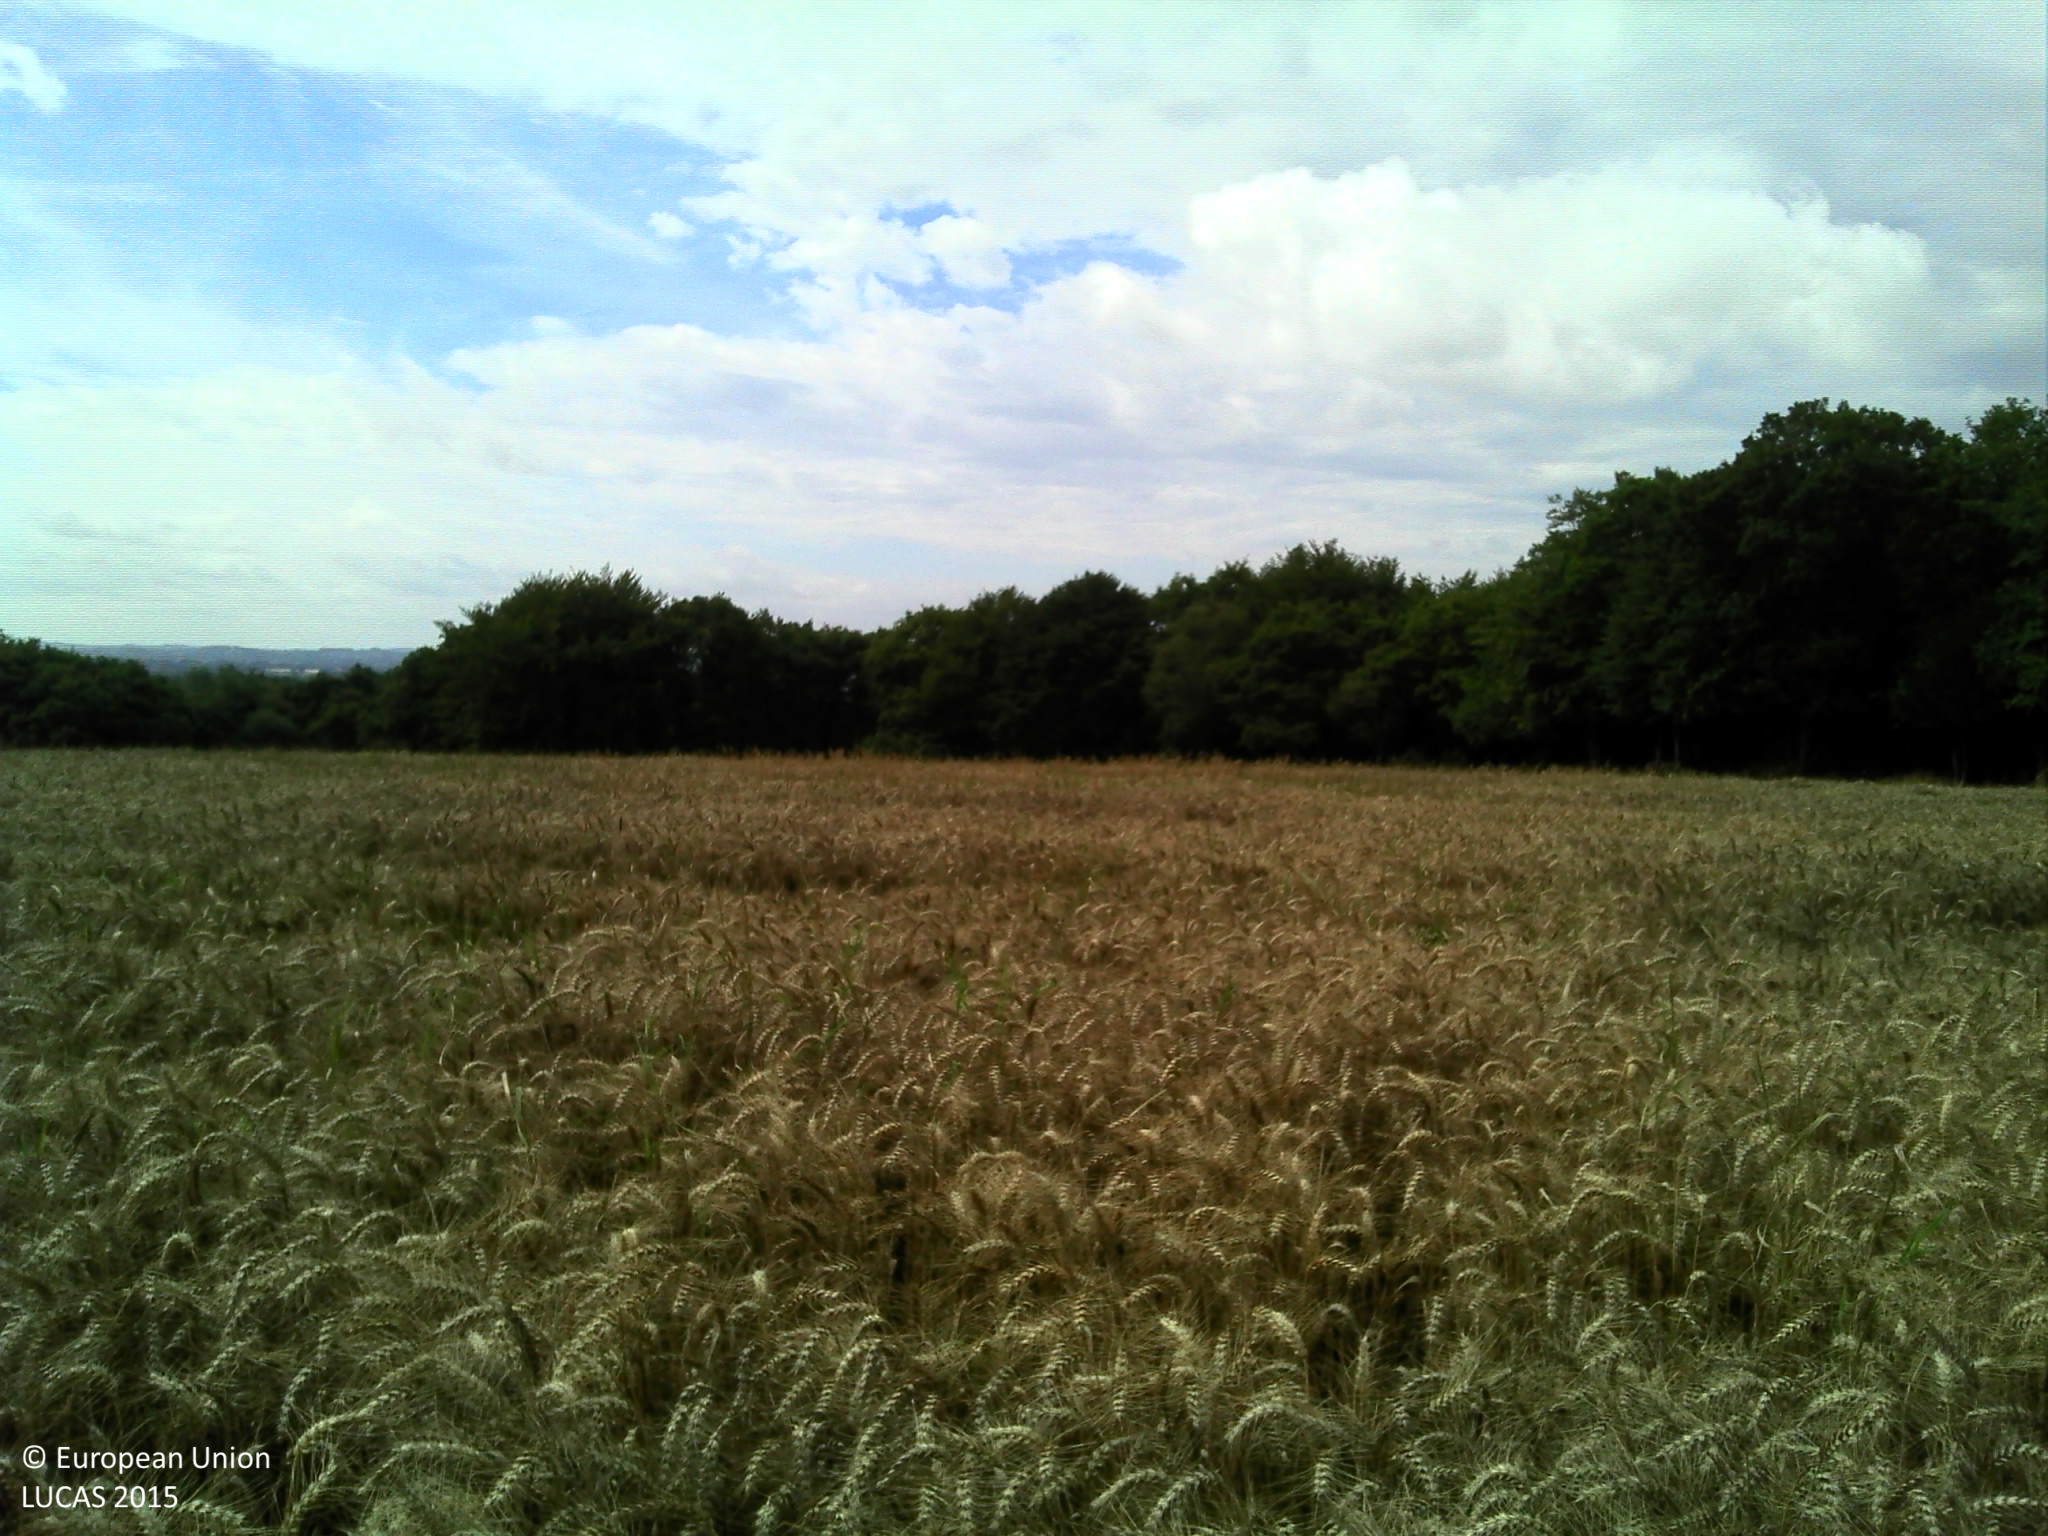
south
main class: Cropland
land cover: Common wheat
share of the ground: > 75 %
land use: Agriculture (excluding fallow land and kitchen gardens)
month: August
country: FR
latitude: 48.3211
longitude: -3.3322
